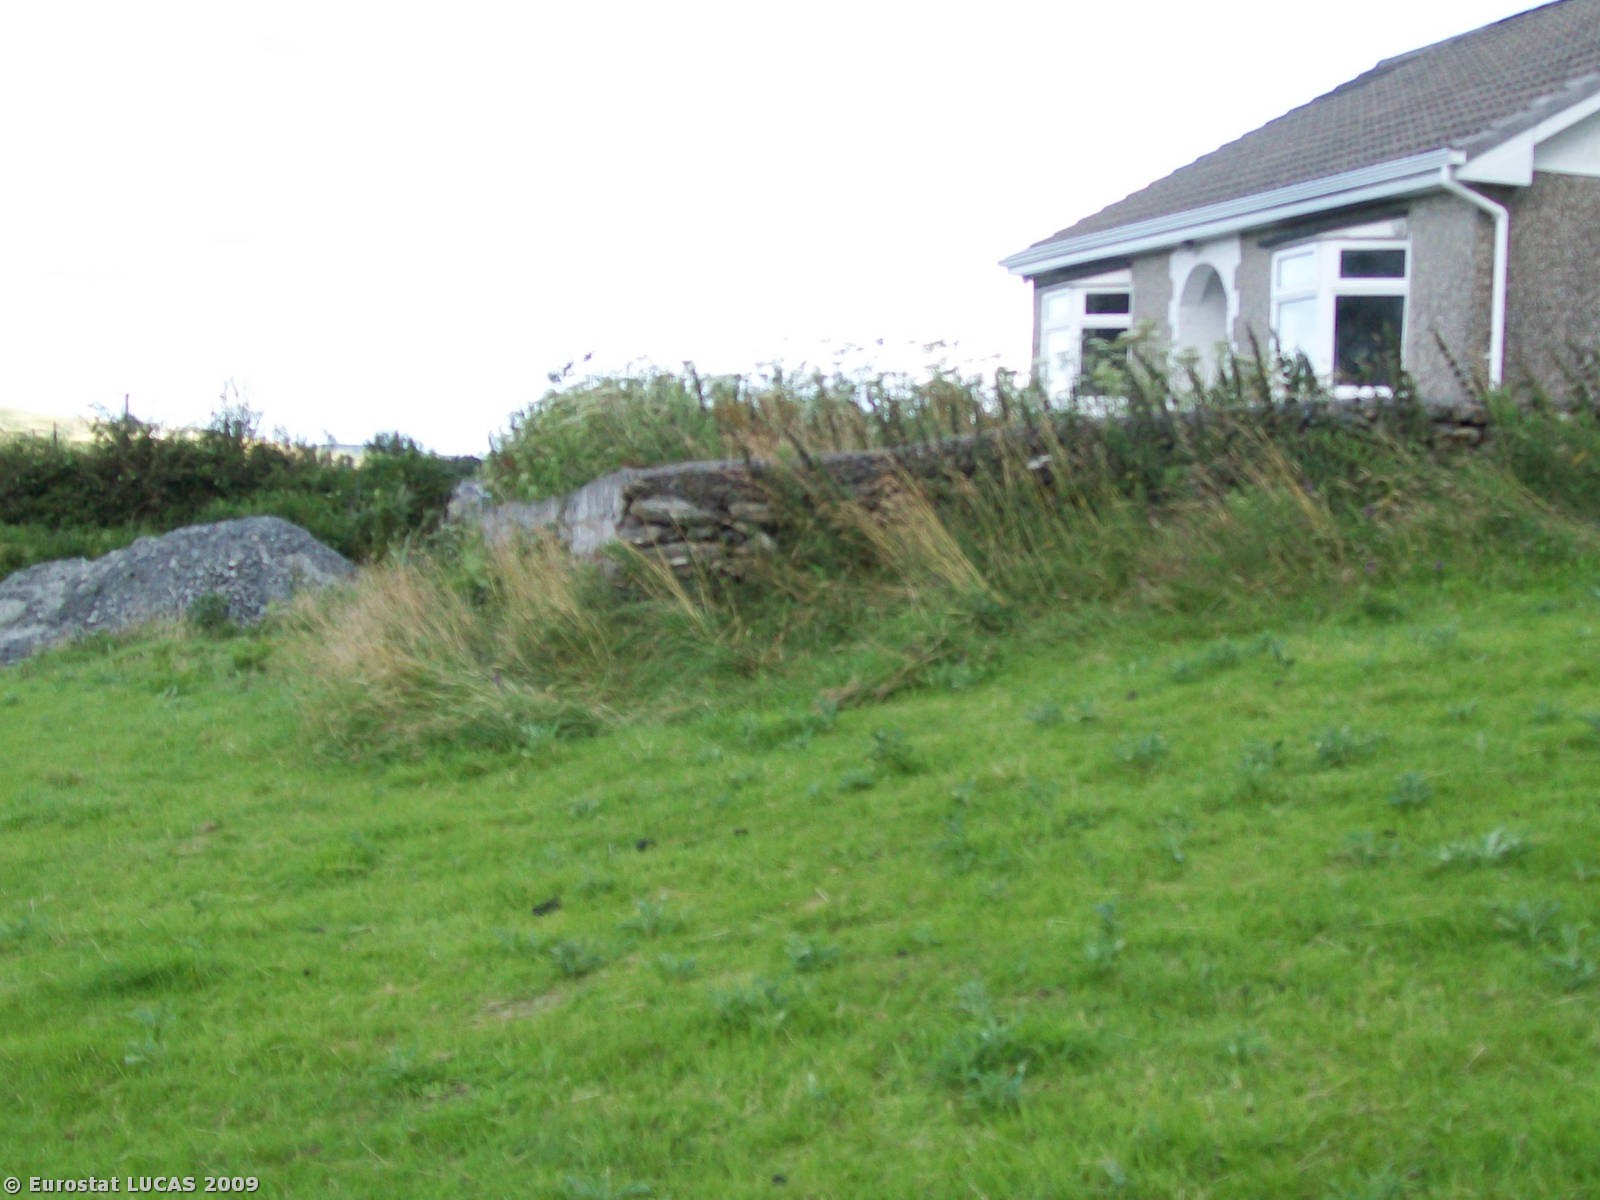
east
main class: Grassland
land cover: Grassland without tree/shrub cover
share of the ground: > 75 %
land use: Agriculture (excluding fallow land and kitchen gardens)
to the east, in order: Grassland without tree/shrub cover; Artificial constructions in urban areas; Abandoned hedges; Grassland without tree/shrub cover; Abandoned hedges; Grassland without tree/shrub cover; Managed hedges; Paved roads, cycling and walking lanes; Abandoned hedges; Grassland without tree/shrub cover
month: July
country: IE
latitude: 53.7643
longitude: -9.5772
